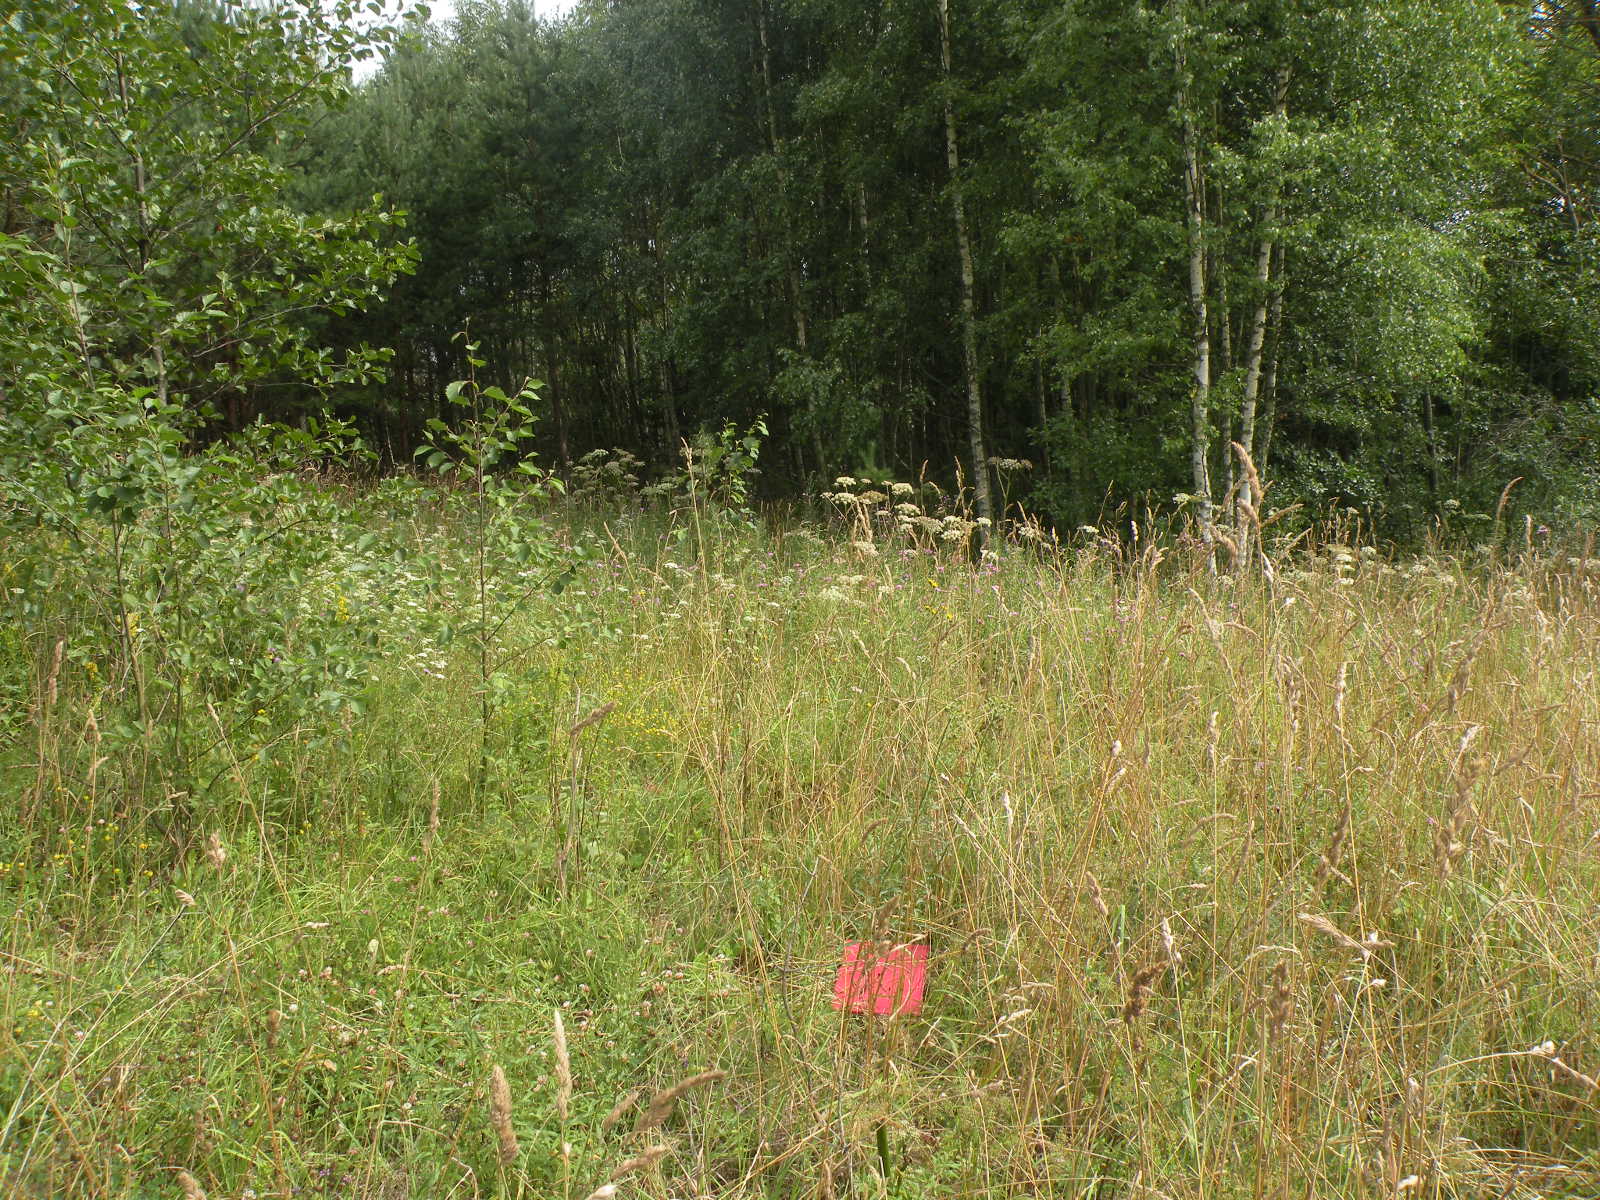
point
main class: Grassland
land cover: Grassland with sparse tree/shrub cover
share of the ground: > 75 %
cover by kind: herbaceous plants 85 %, shrubs 10 %, coniferous forest trees 5 %
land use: Semi-natural and natural areas not in use
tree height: < 5 m
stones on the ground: < 10 %
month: July
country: LV
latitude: 55.8225
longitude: 26.9399
